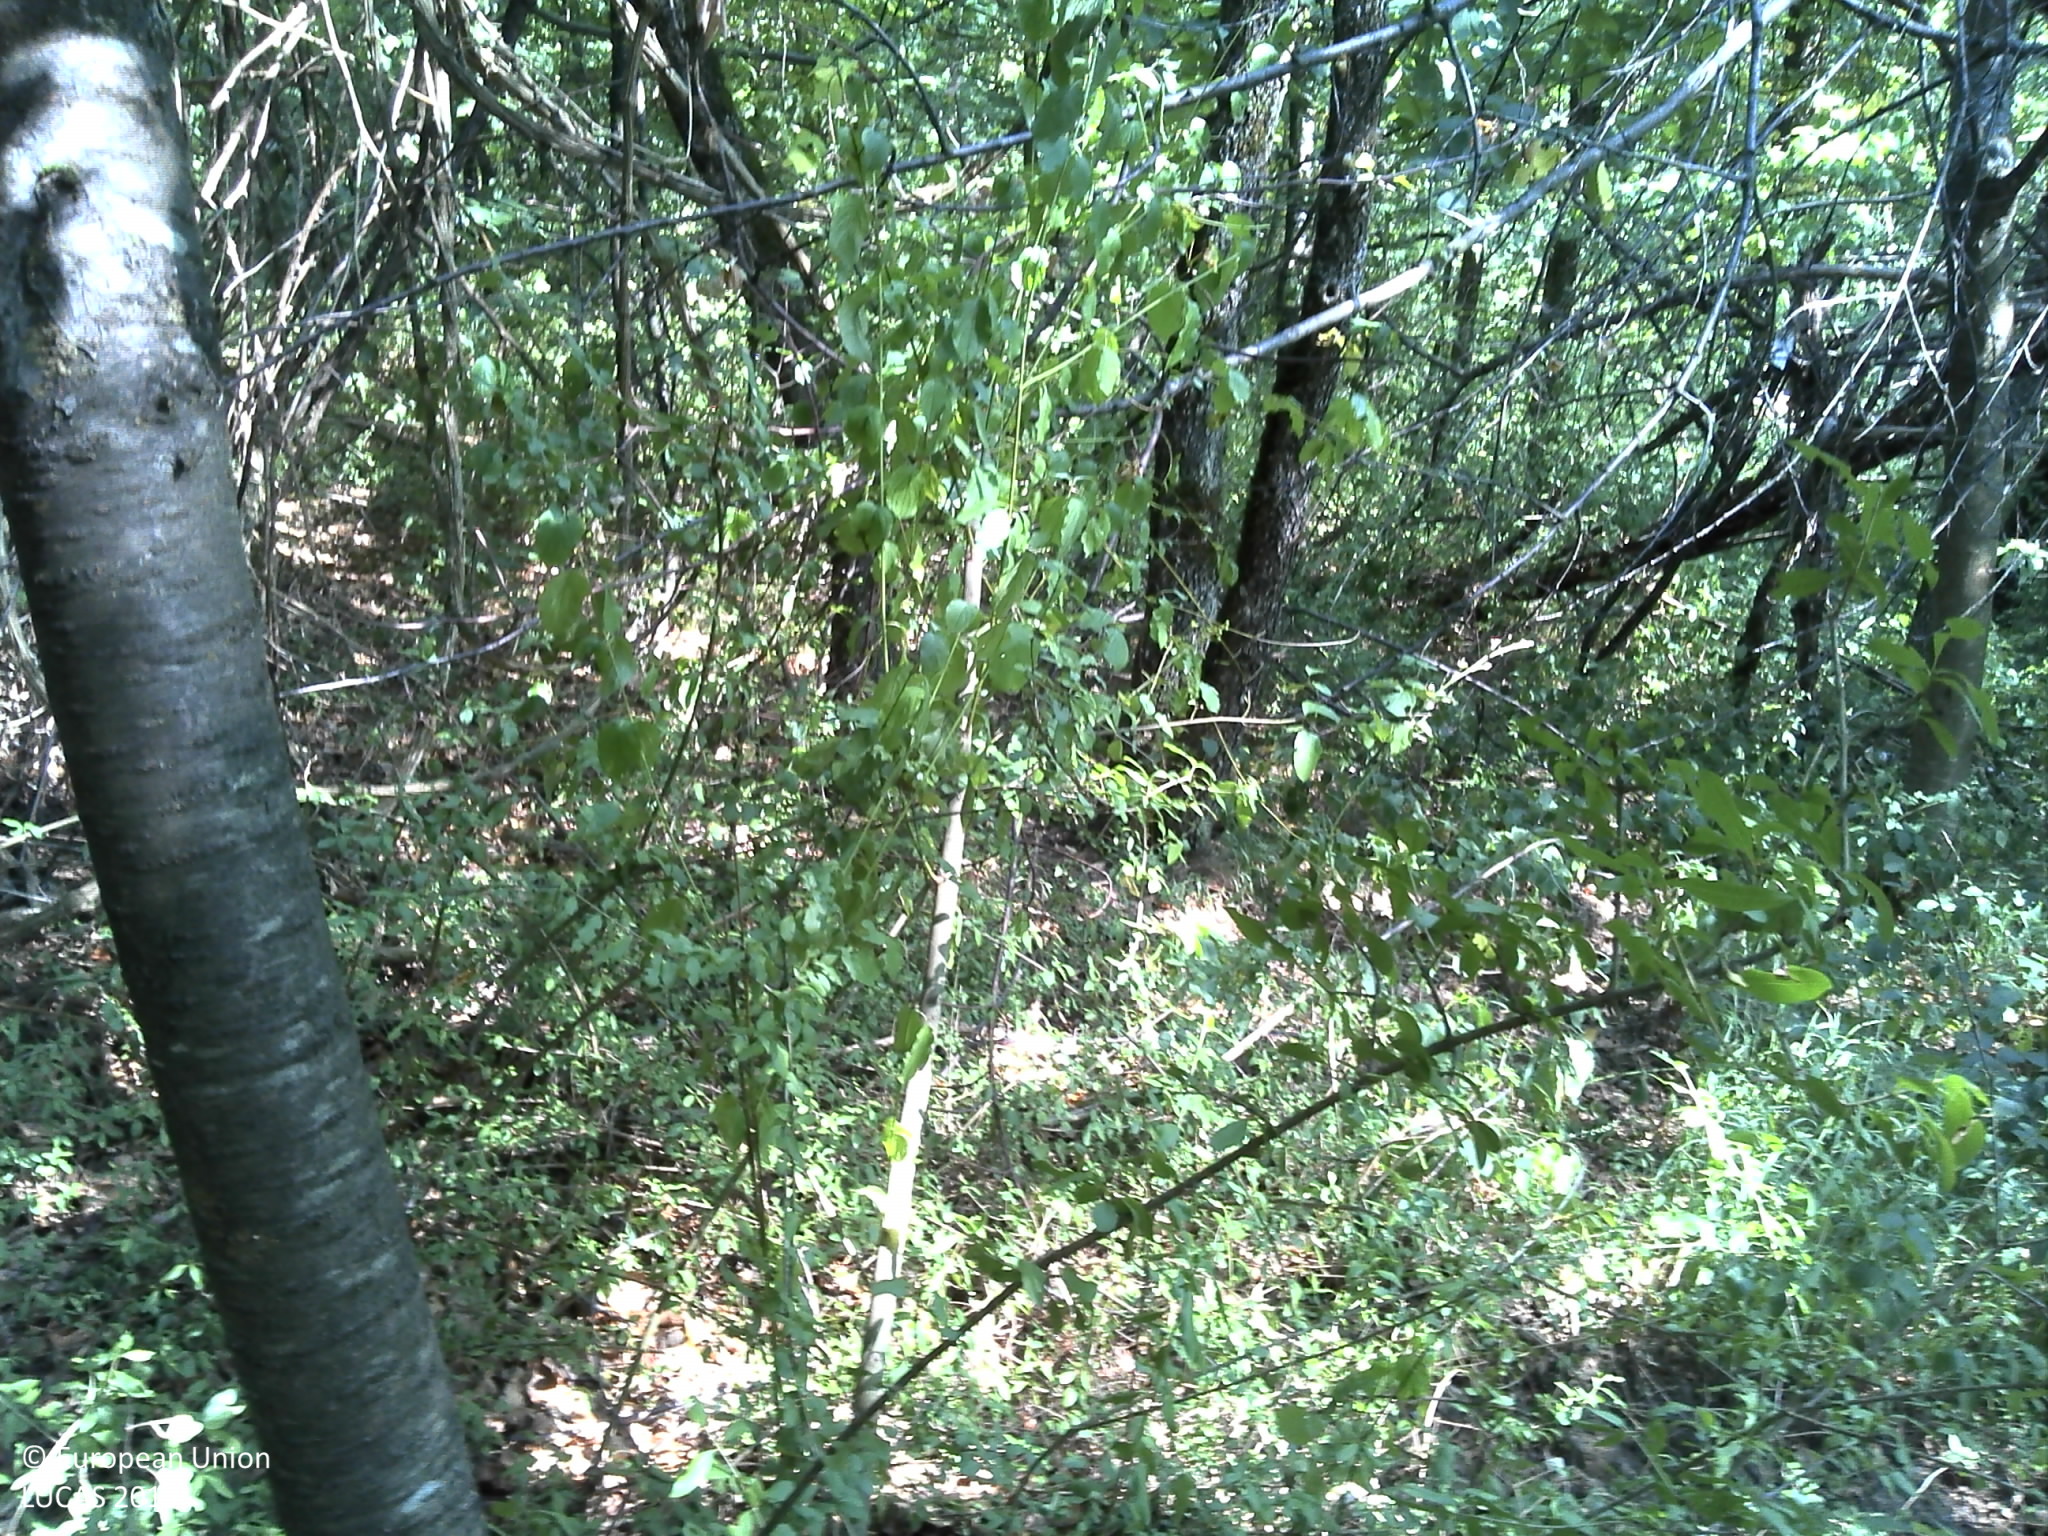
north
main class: Woodland
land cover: Broadleaved woodland
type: beech forest
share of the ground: > 75 %
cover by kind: broadleaved forest trees 100 %
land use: Forestry
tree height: > 5 m
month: August
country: HR
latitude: 45.5723
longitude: 17.3693
